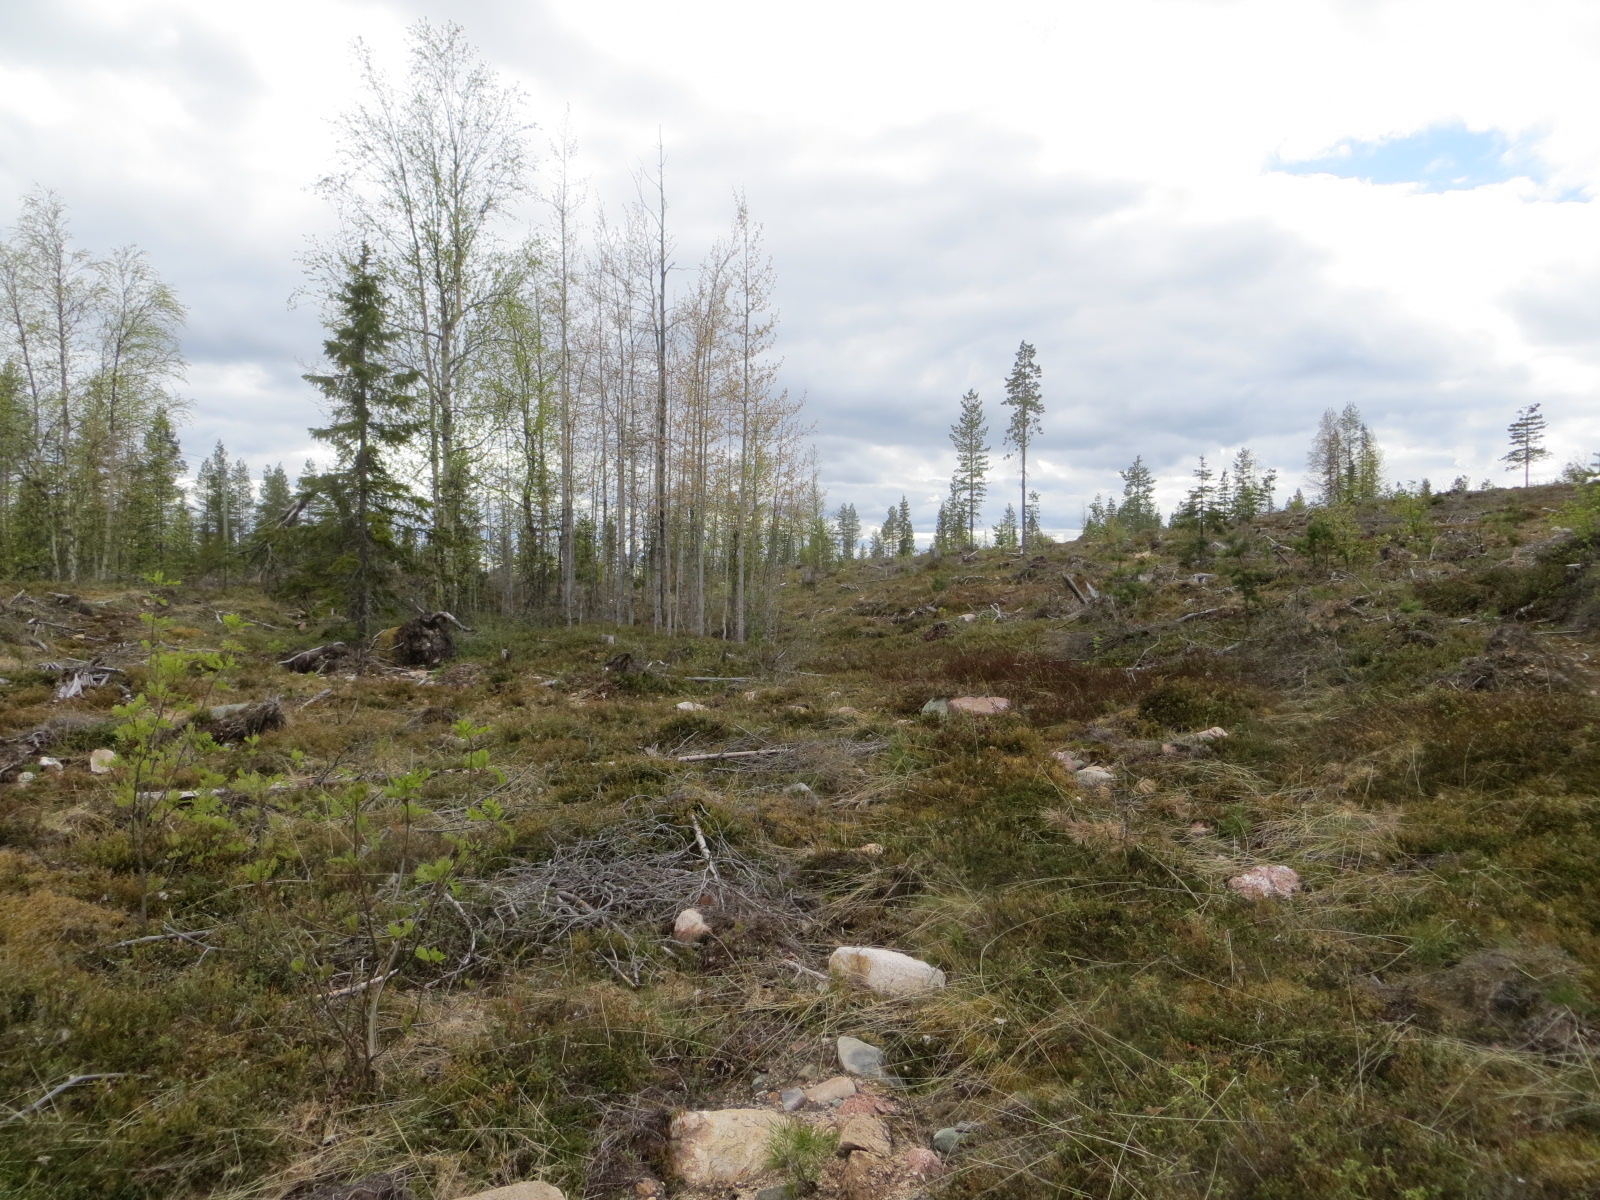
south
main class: Shrubland
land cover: Shrubland with sparse tree cover
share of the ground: > 75 %
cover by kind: shrubs 70 %, herbaceous plants 10 %, unconsolidated bare surface 10 %, coniferous forest trees 5 %, lichens and mosses 5 %
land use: Forestry
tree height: < 5 m
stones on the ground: 25 - 50 %
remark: Clear cut
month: June
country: FI
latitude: 67.6072
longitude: 24.9262
